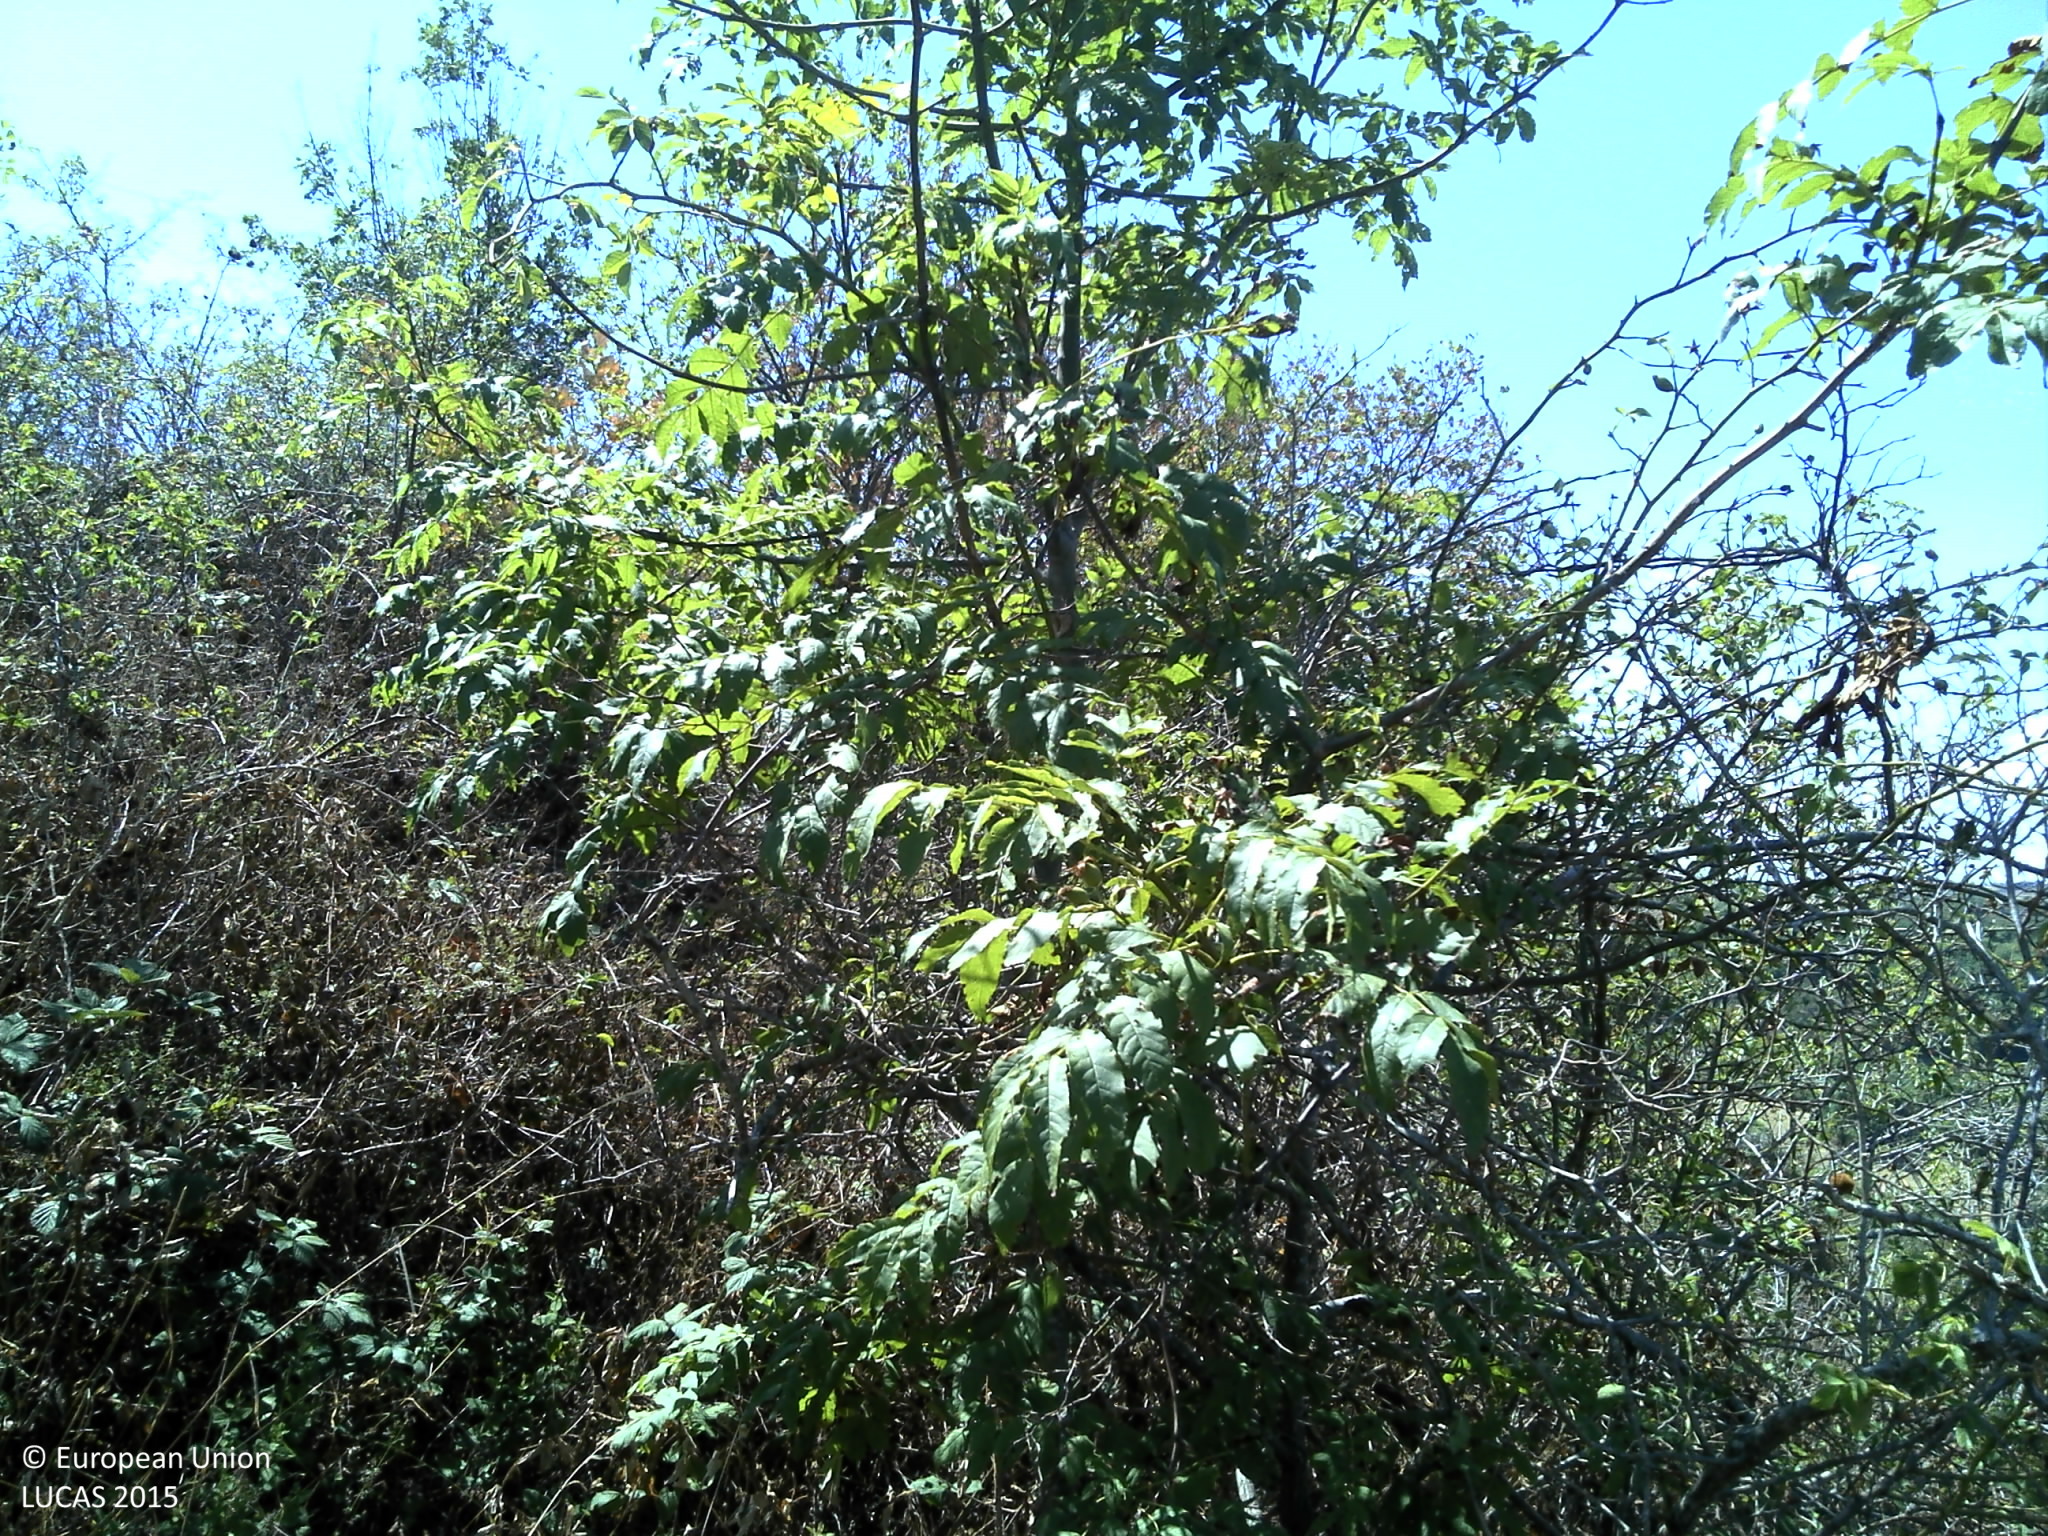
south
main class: Woodland
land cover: Broadleaved woodland
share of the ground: > 75 %
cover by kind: herbaceous plants 50 %, broadleaved forest trees 30 %, shrubs 20 %
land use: Semi-natural and natural areas not in use
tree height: < 5 m
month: July
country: FR
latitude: 45.9869
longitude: 4.0505
